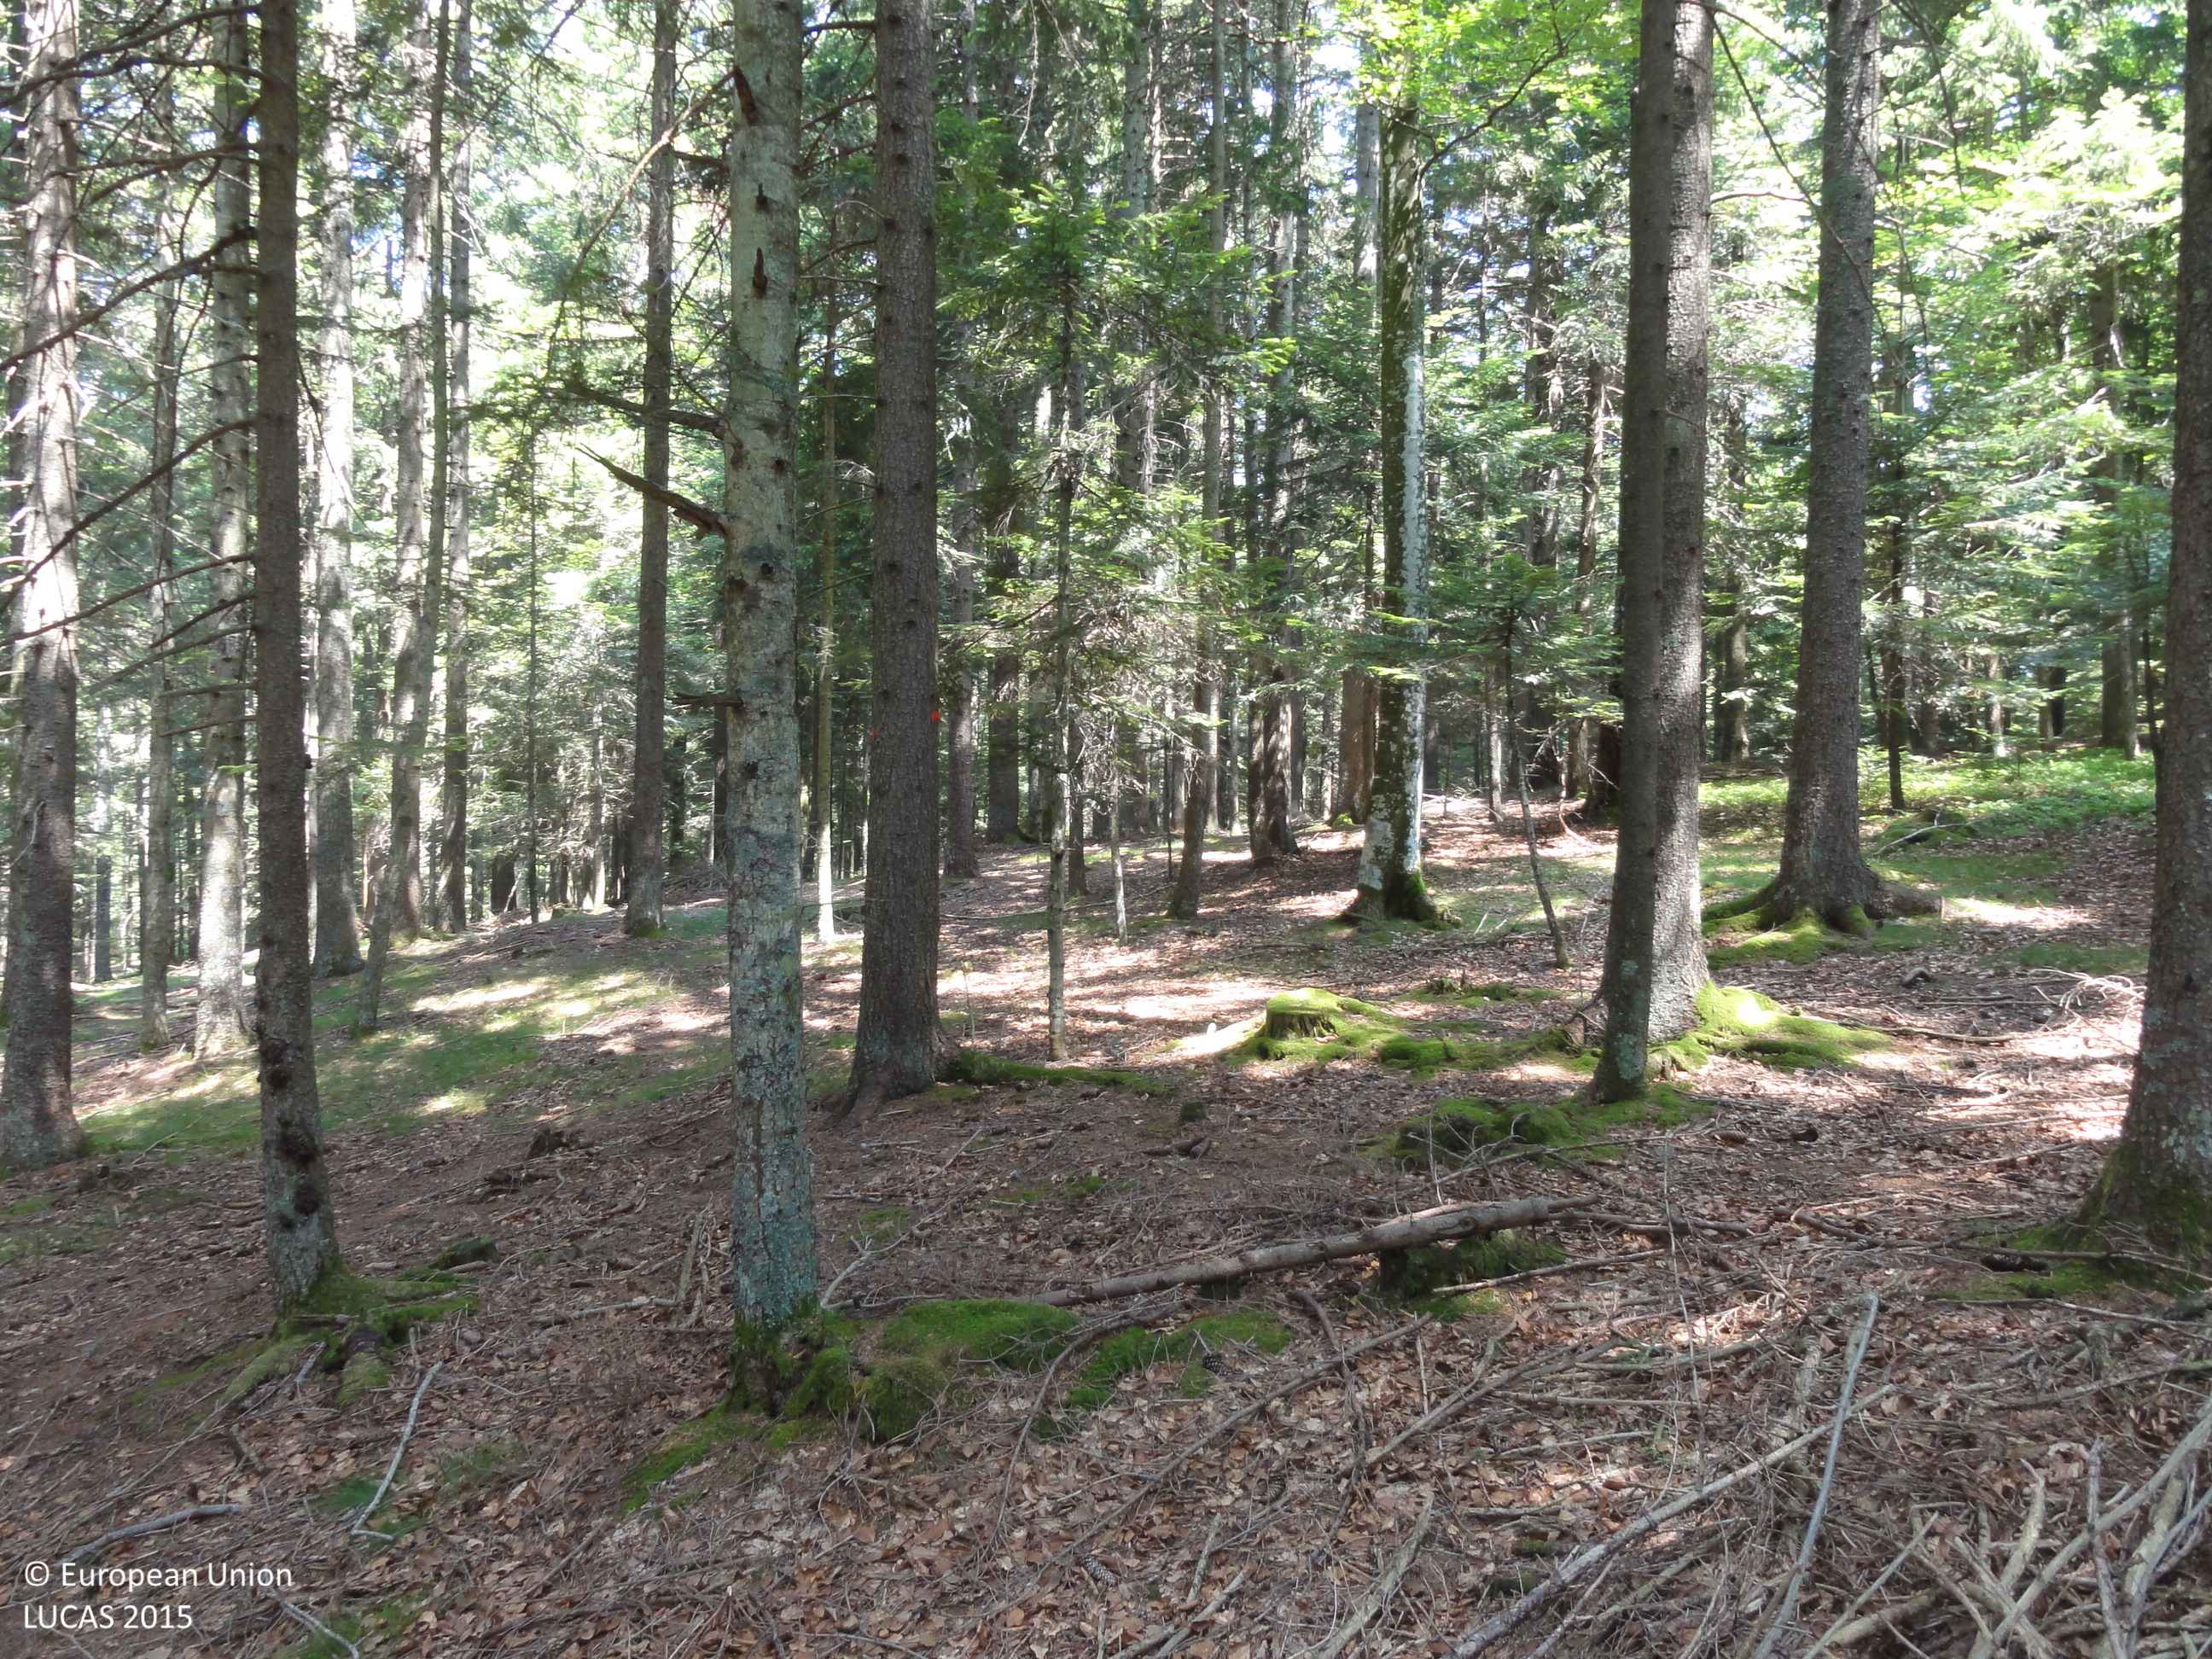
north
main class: Woodland
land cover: Spruce dominated coniferous woodland
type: hemiboreal forest and nemoral coniferous forest and mixed broadleaved-coniferous forest
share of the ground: > 75 %
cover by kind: coniferous forest trees 85 %, broadleaved forest trees 15 %
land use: Forestry
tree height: > 5 m
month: July
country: SI
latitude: 46.4634
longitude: 15.4806
